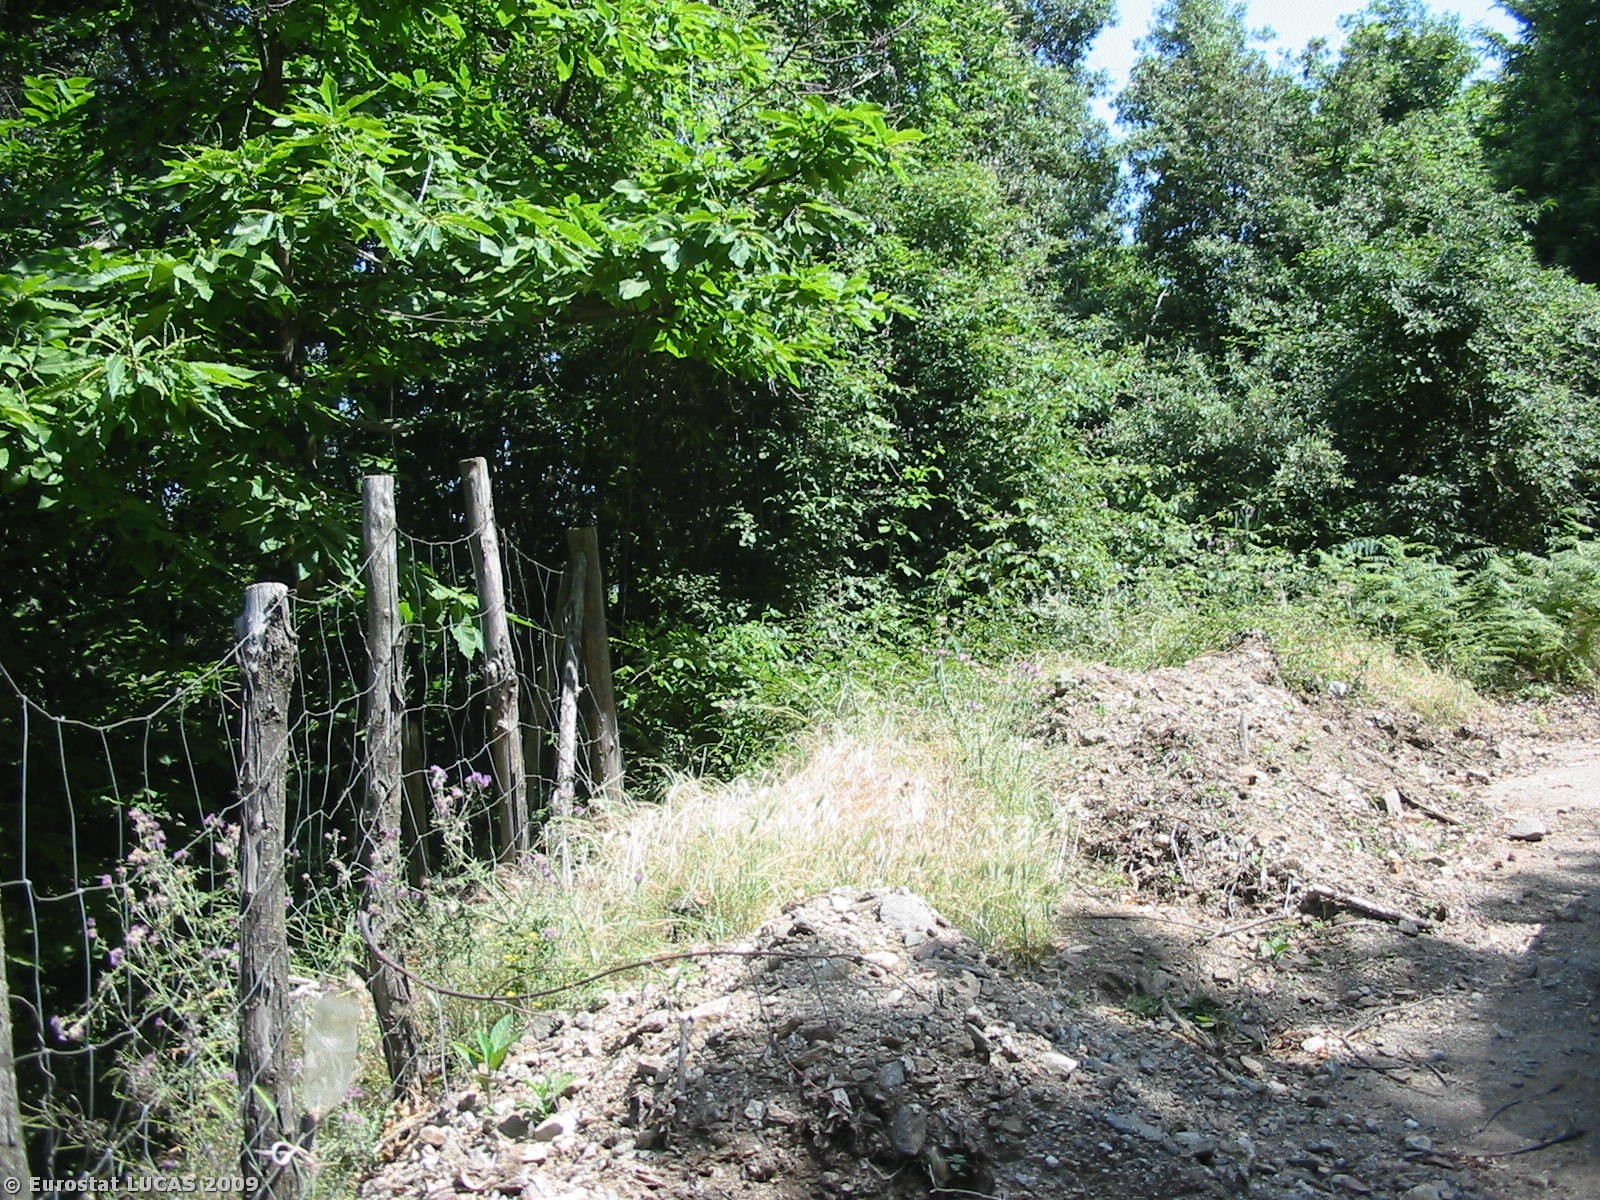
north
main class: Cropland
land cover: Olive groves
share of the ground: 50 - 75 %
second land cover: Spontaneously vegetated surfaces
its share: > 75 %
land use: Agriculture (excluding fallow land and kitchen gardens)
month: June
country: IT
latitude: 38.2348
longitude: 15.9389
